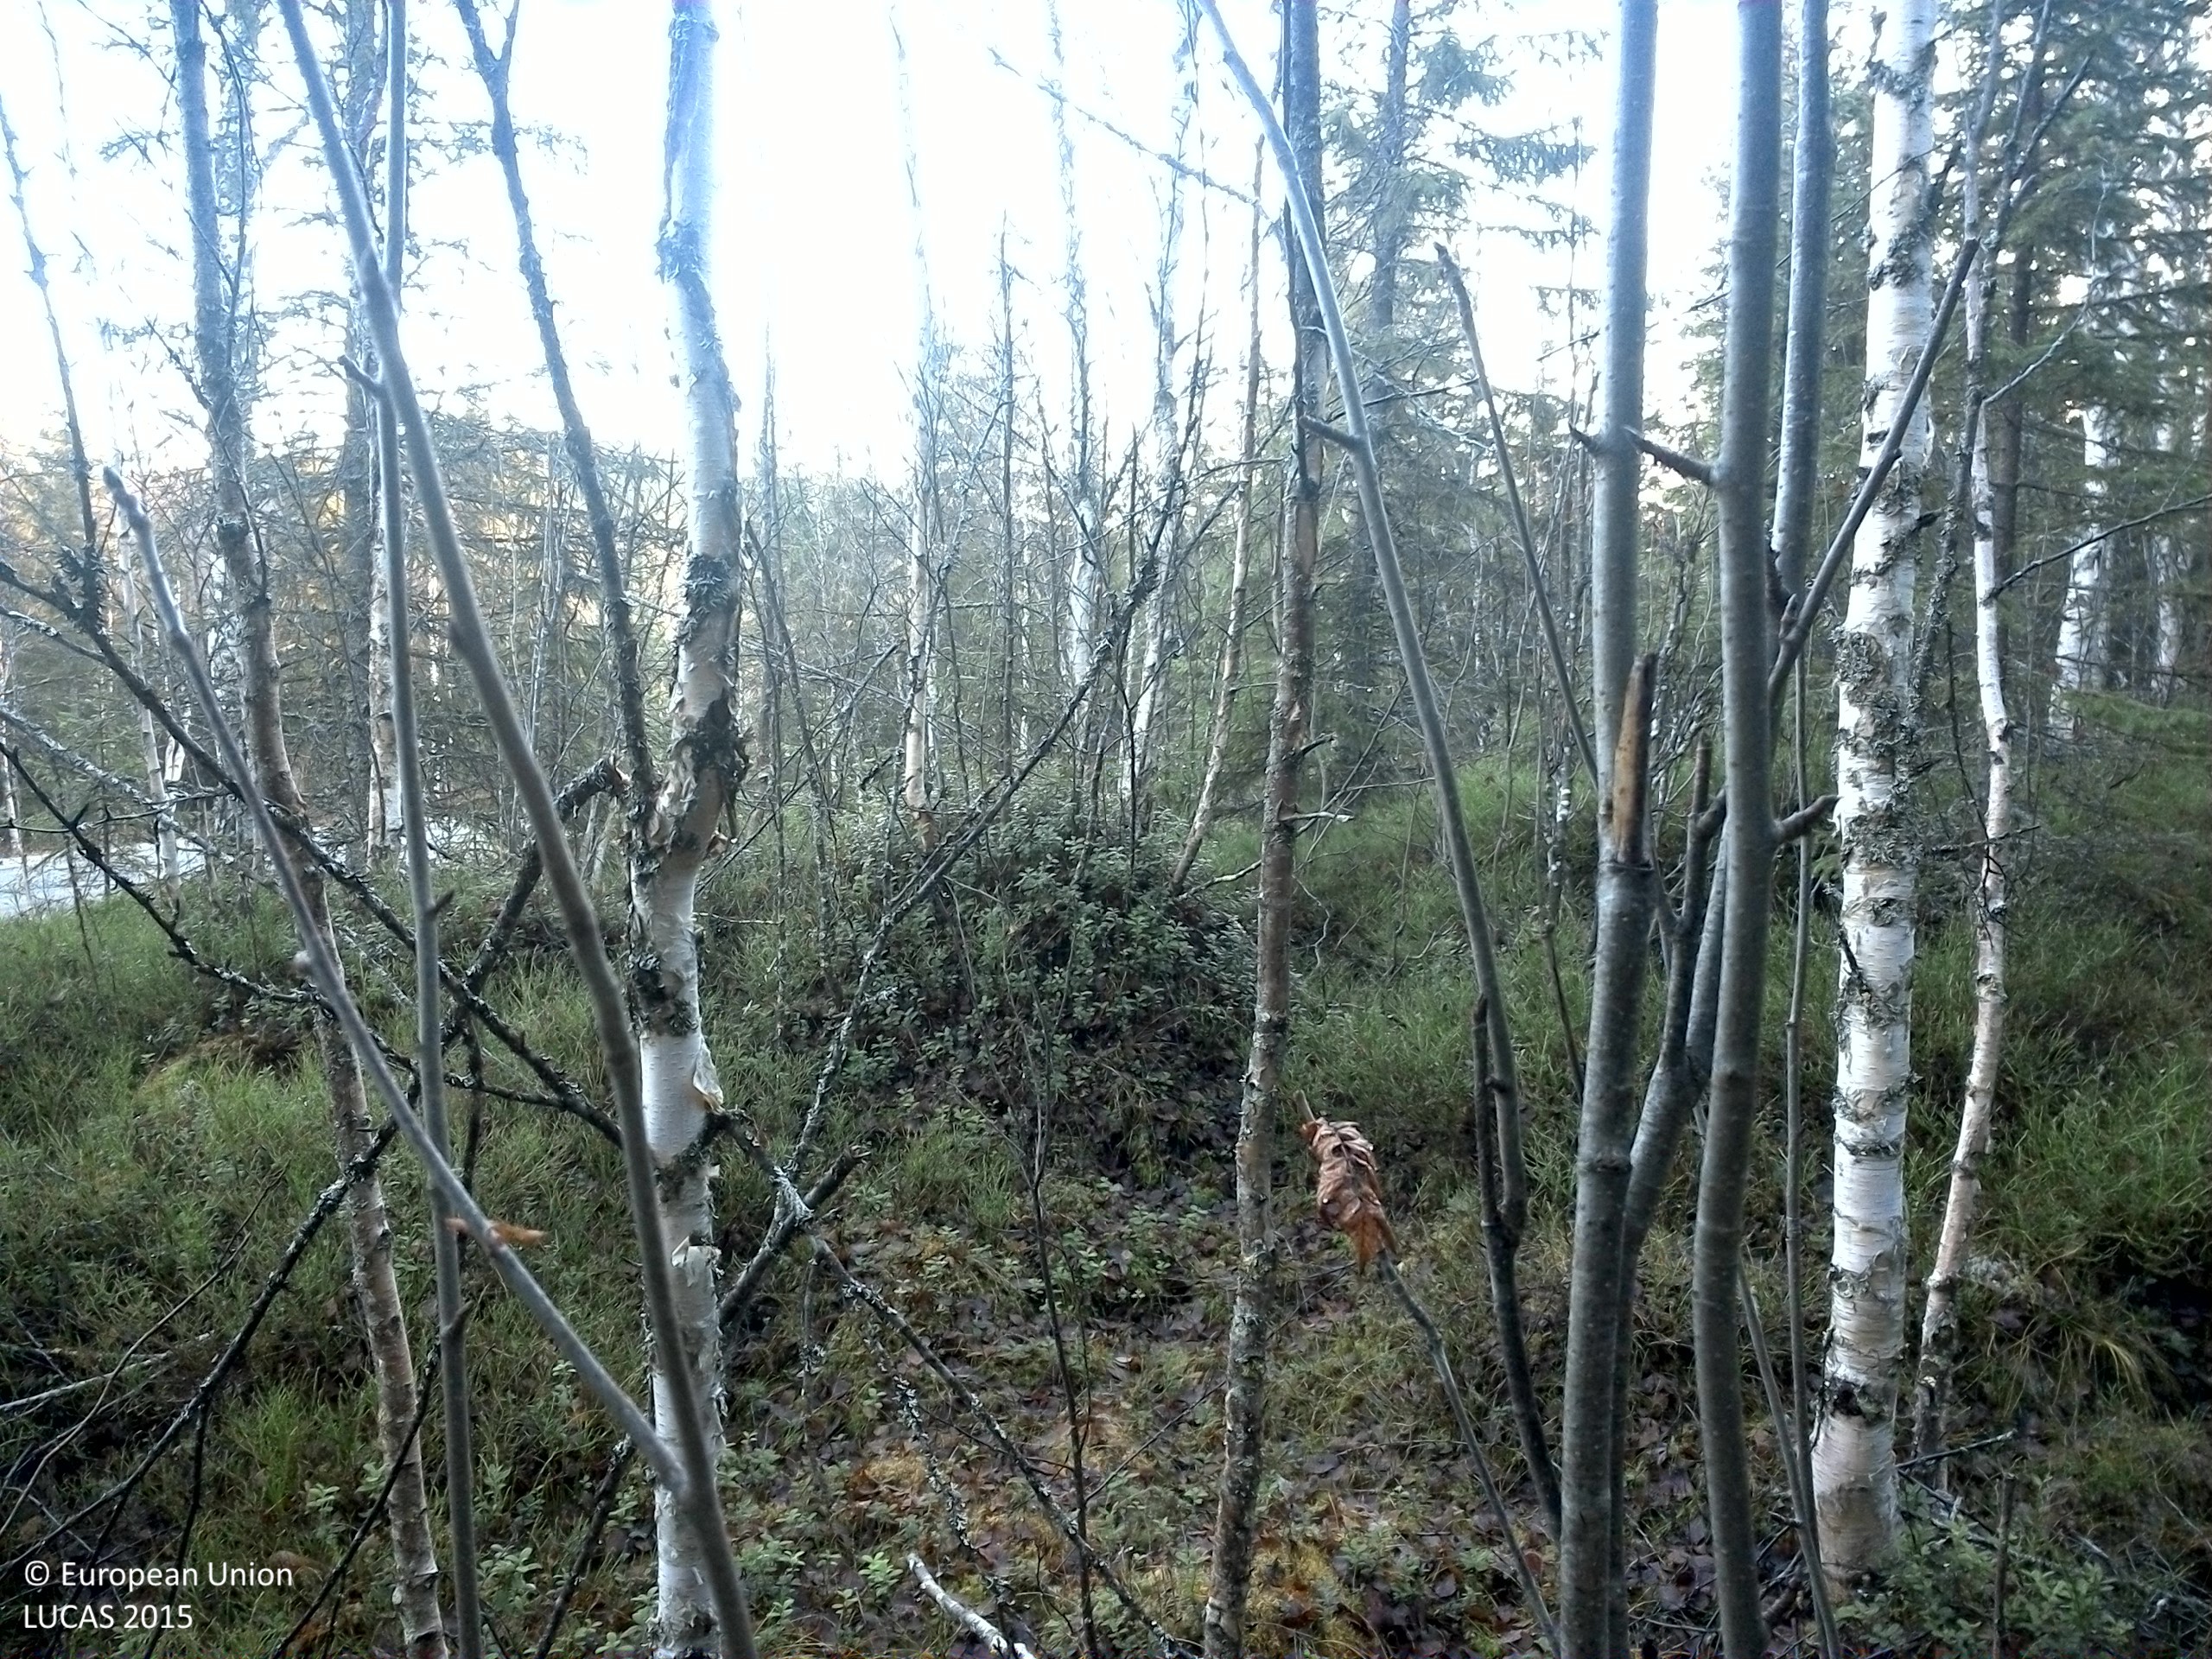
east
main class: Woodland
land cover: Spruce dominated mixed woodland
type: boreal forest
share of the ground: 50 - 75 %
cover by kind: coniferous forest trees 45 %, broadleaved forest trees 20 %, shrubs 20 %, lichens and mosses 15 %
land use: Forestry
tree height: > 5 m
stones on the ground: > 50 %
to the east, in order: Spruce dominated mixed woodland; Ditches and canals; Paved roads, cycling and walking lanes; Shruby margins; Spruce dominated mixed woodland; Pine dominated coniferous woodland; Inland marshes
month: October
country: SE
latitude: 64.0292
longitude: 15.5599
